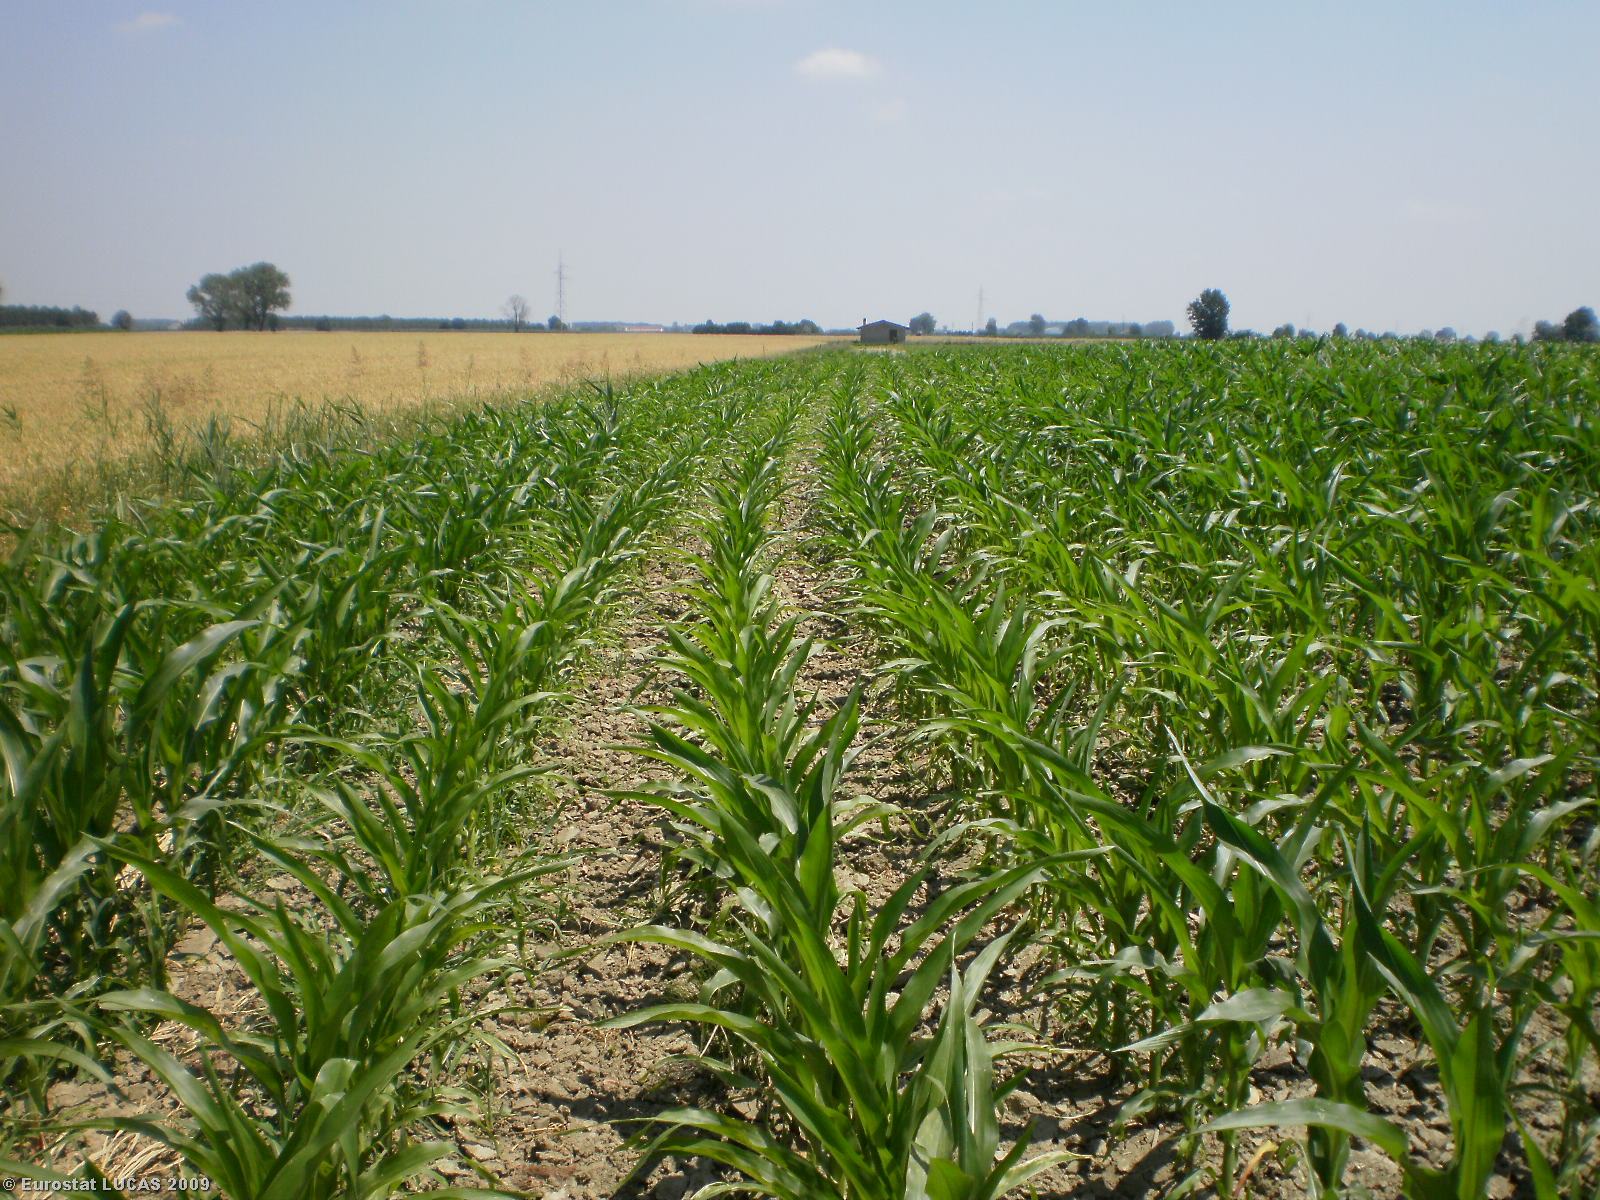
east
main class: Woodland
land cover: Broadleaved woodland
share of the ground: > 75 %
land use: Unused
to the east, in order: Broadleaved woodland; Maize; Ditches and canals; Common wheat
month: June
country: IT
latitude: 45.0352
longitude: 10.3421
